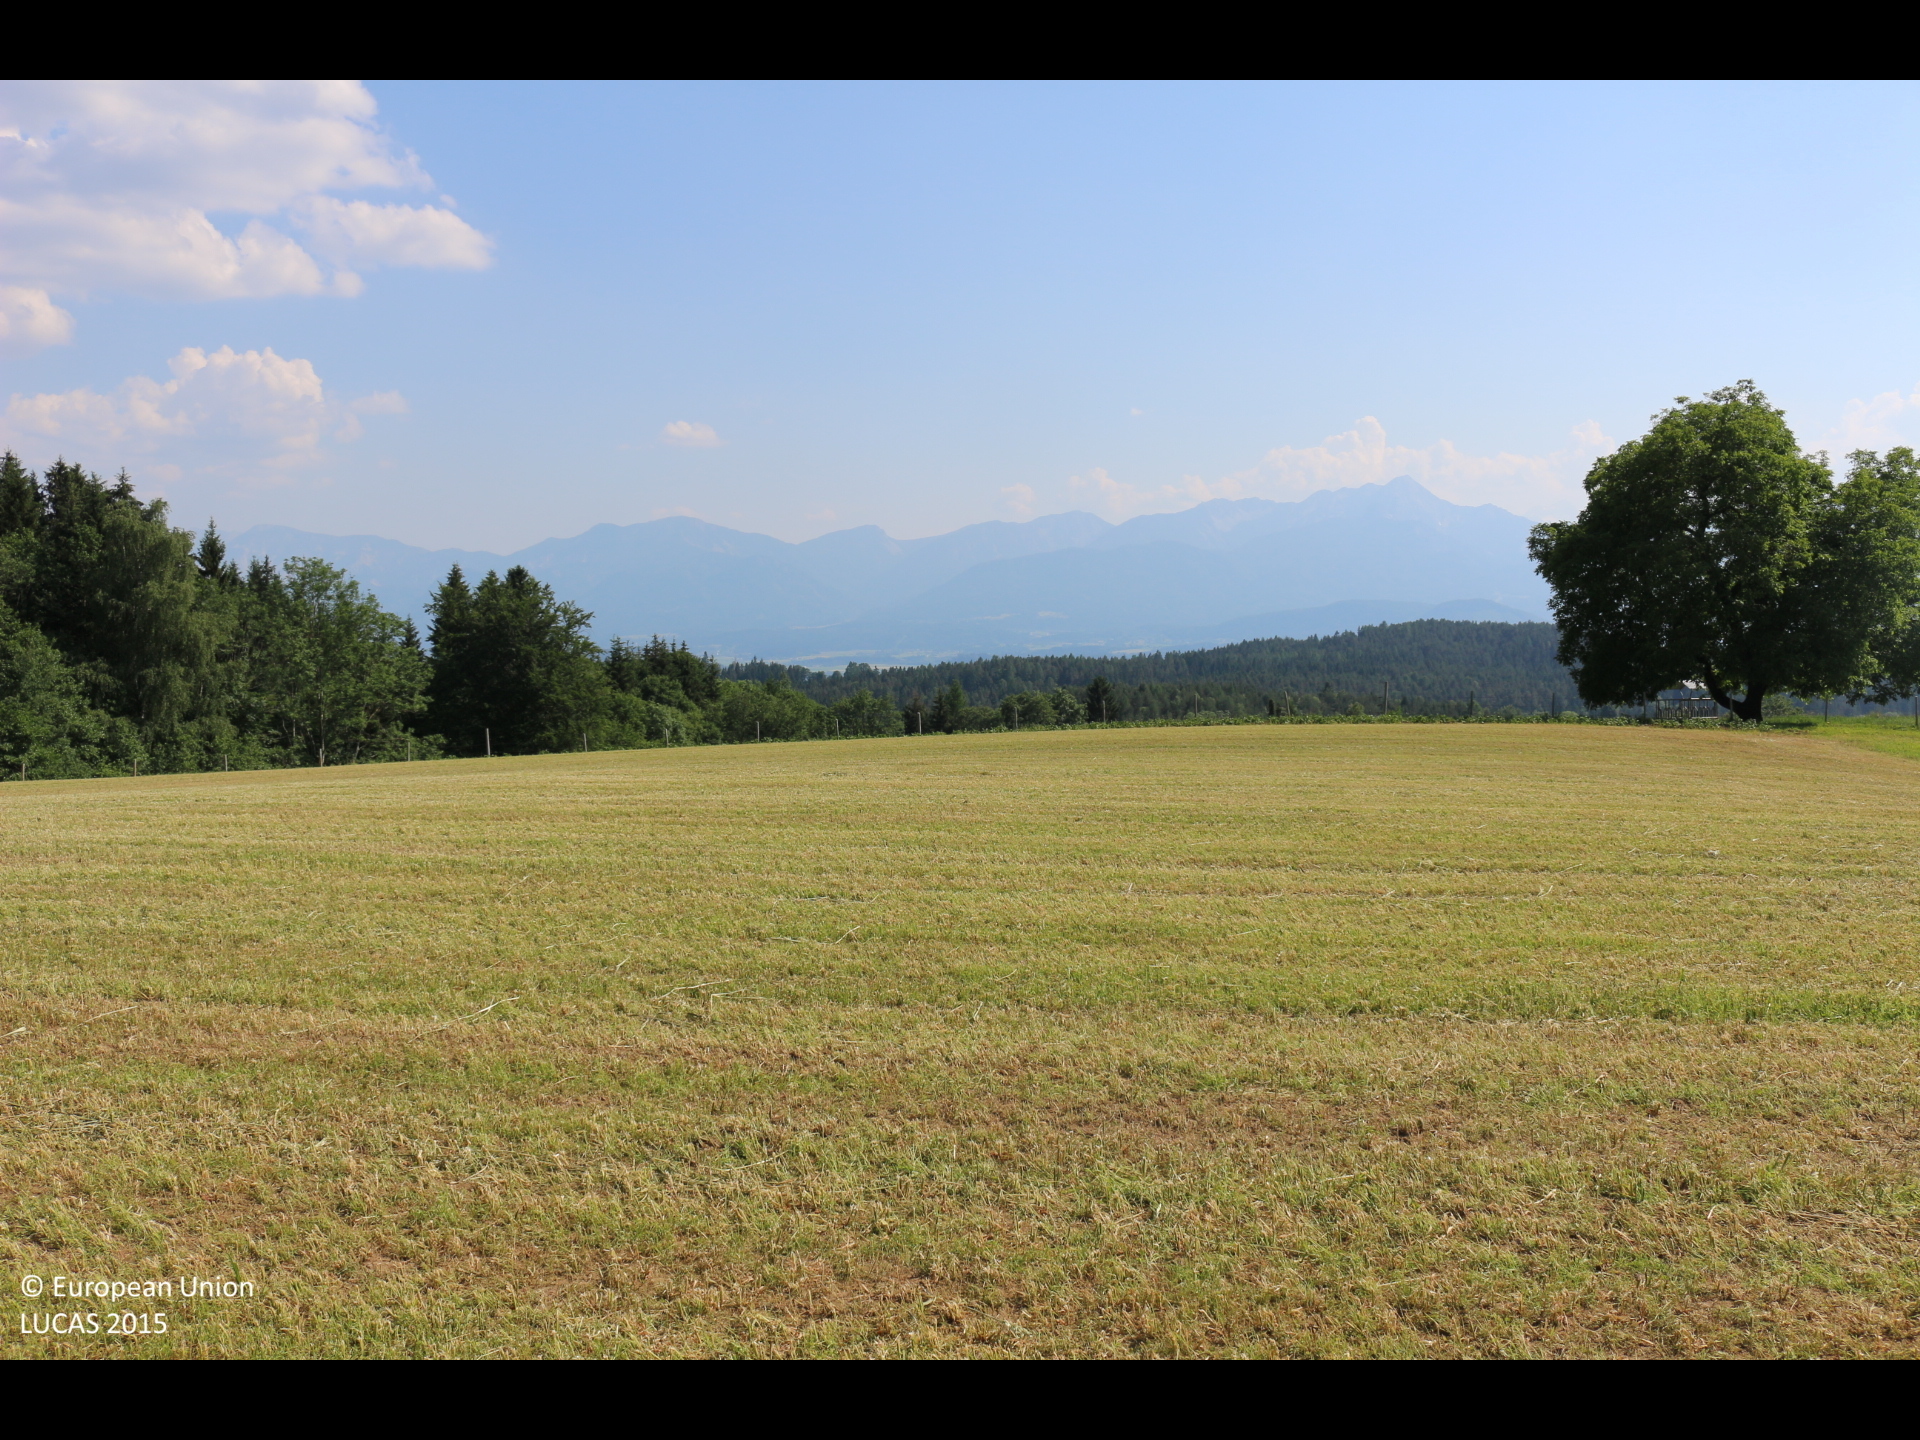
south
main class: Grassland
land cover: Grassland without tree/shrub cover
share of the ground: > 75 %
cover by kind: herbaceous plants 100 %
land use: Agriculture (excluding fallow land and kitchen gardens)
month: June
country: AT
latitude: 46.6538
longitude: 14.0351
